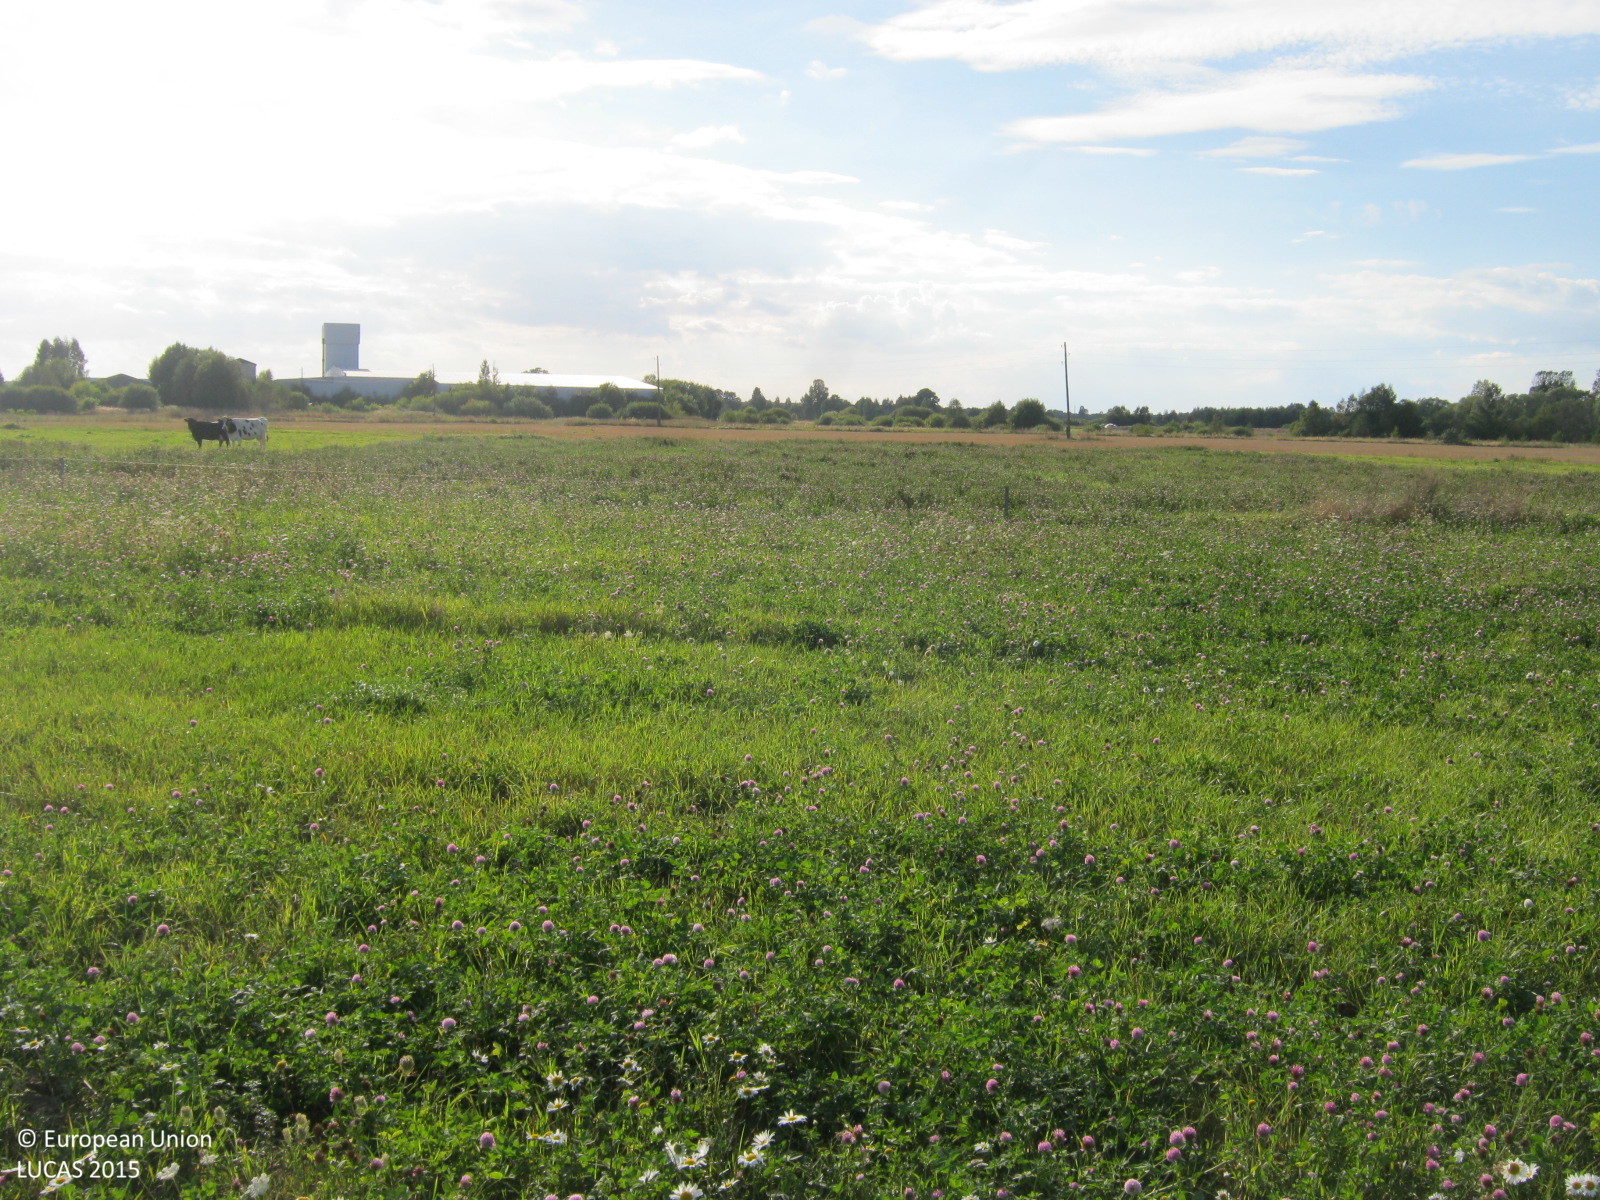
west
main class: Cropland
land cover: Clovers
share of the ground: > 75 %
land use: Agriculture (excluding fallow land and kitchen gardens)
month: September
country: LV
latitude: 57.3360
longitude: 24.4951
